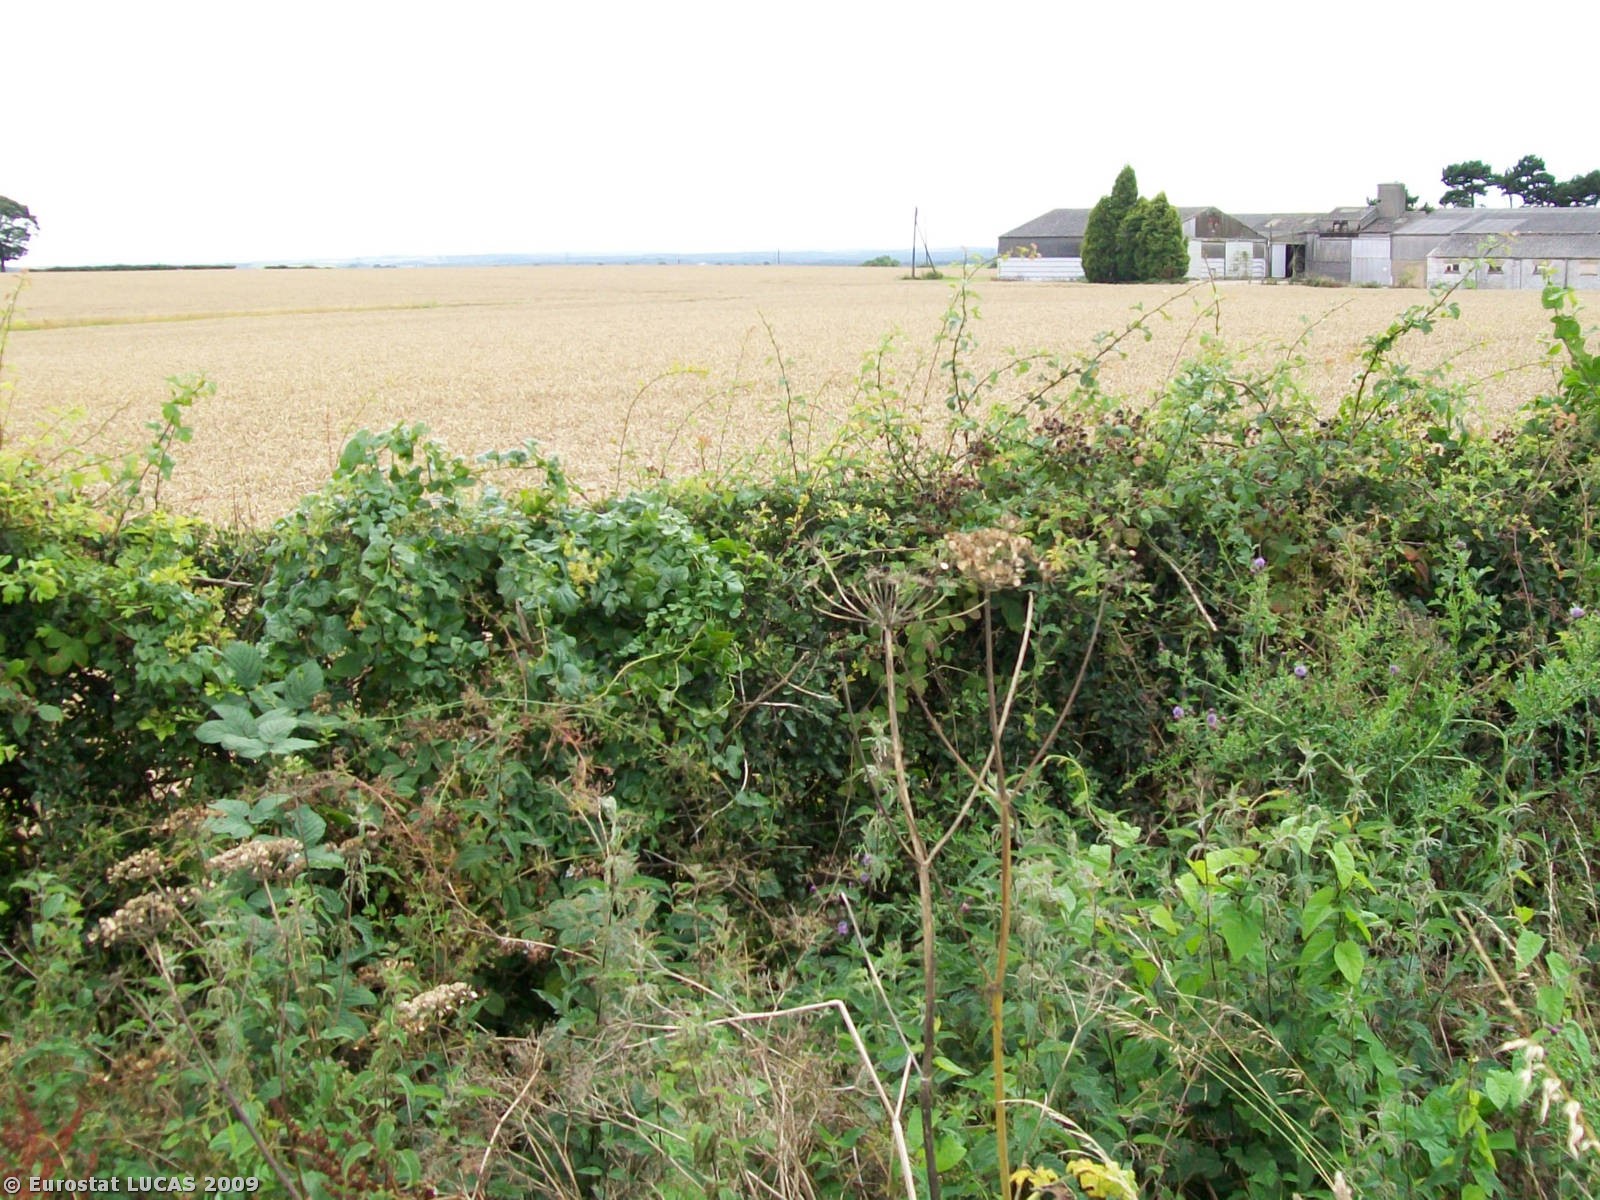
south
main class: Cropland
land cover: Common wheat
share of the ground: > 75 %
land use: Agriculture (excluding fallow land and kitchen gardens)
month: August
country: GB
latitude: 53.1937
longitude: -0.9546
